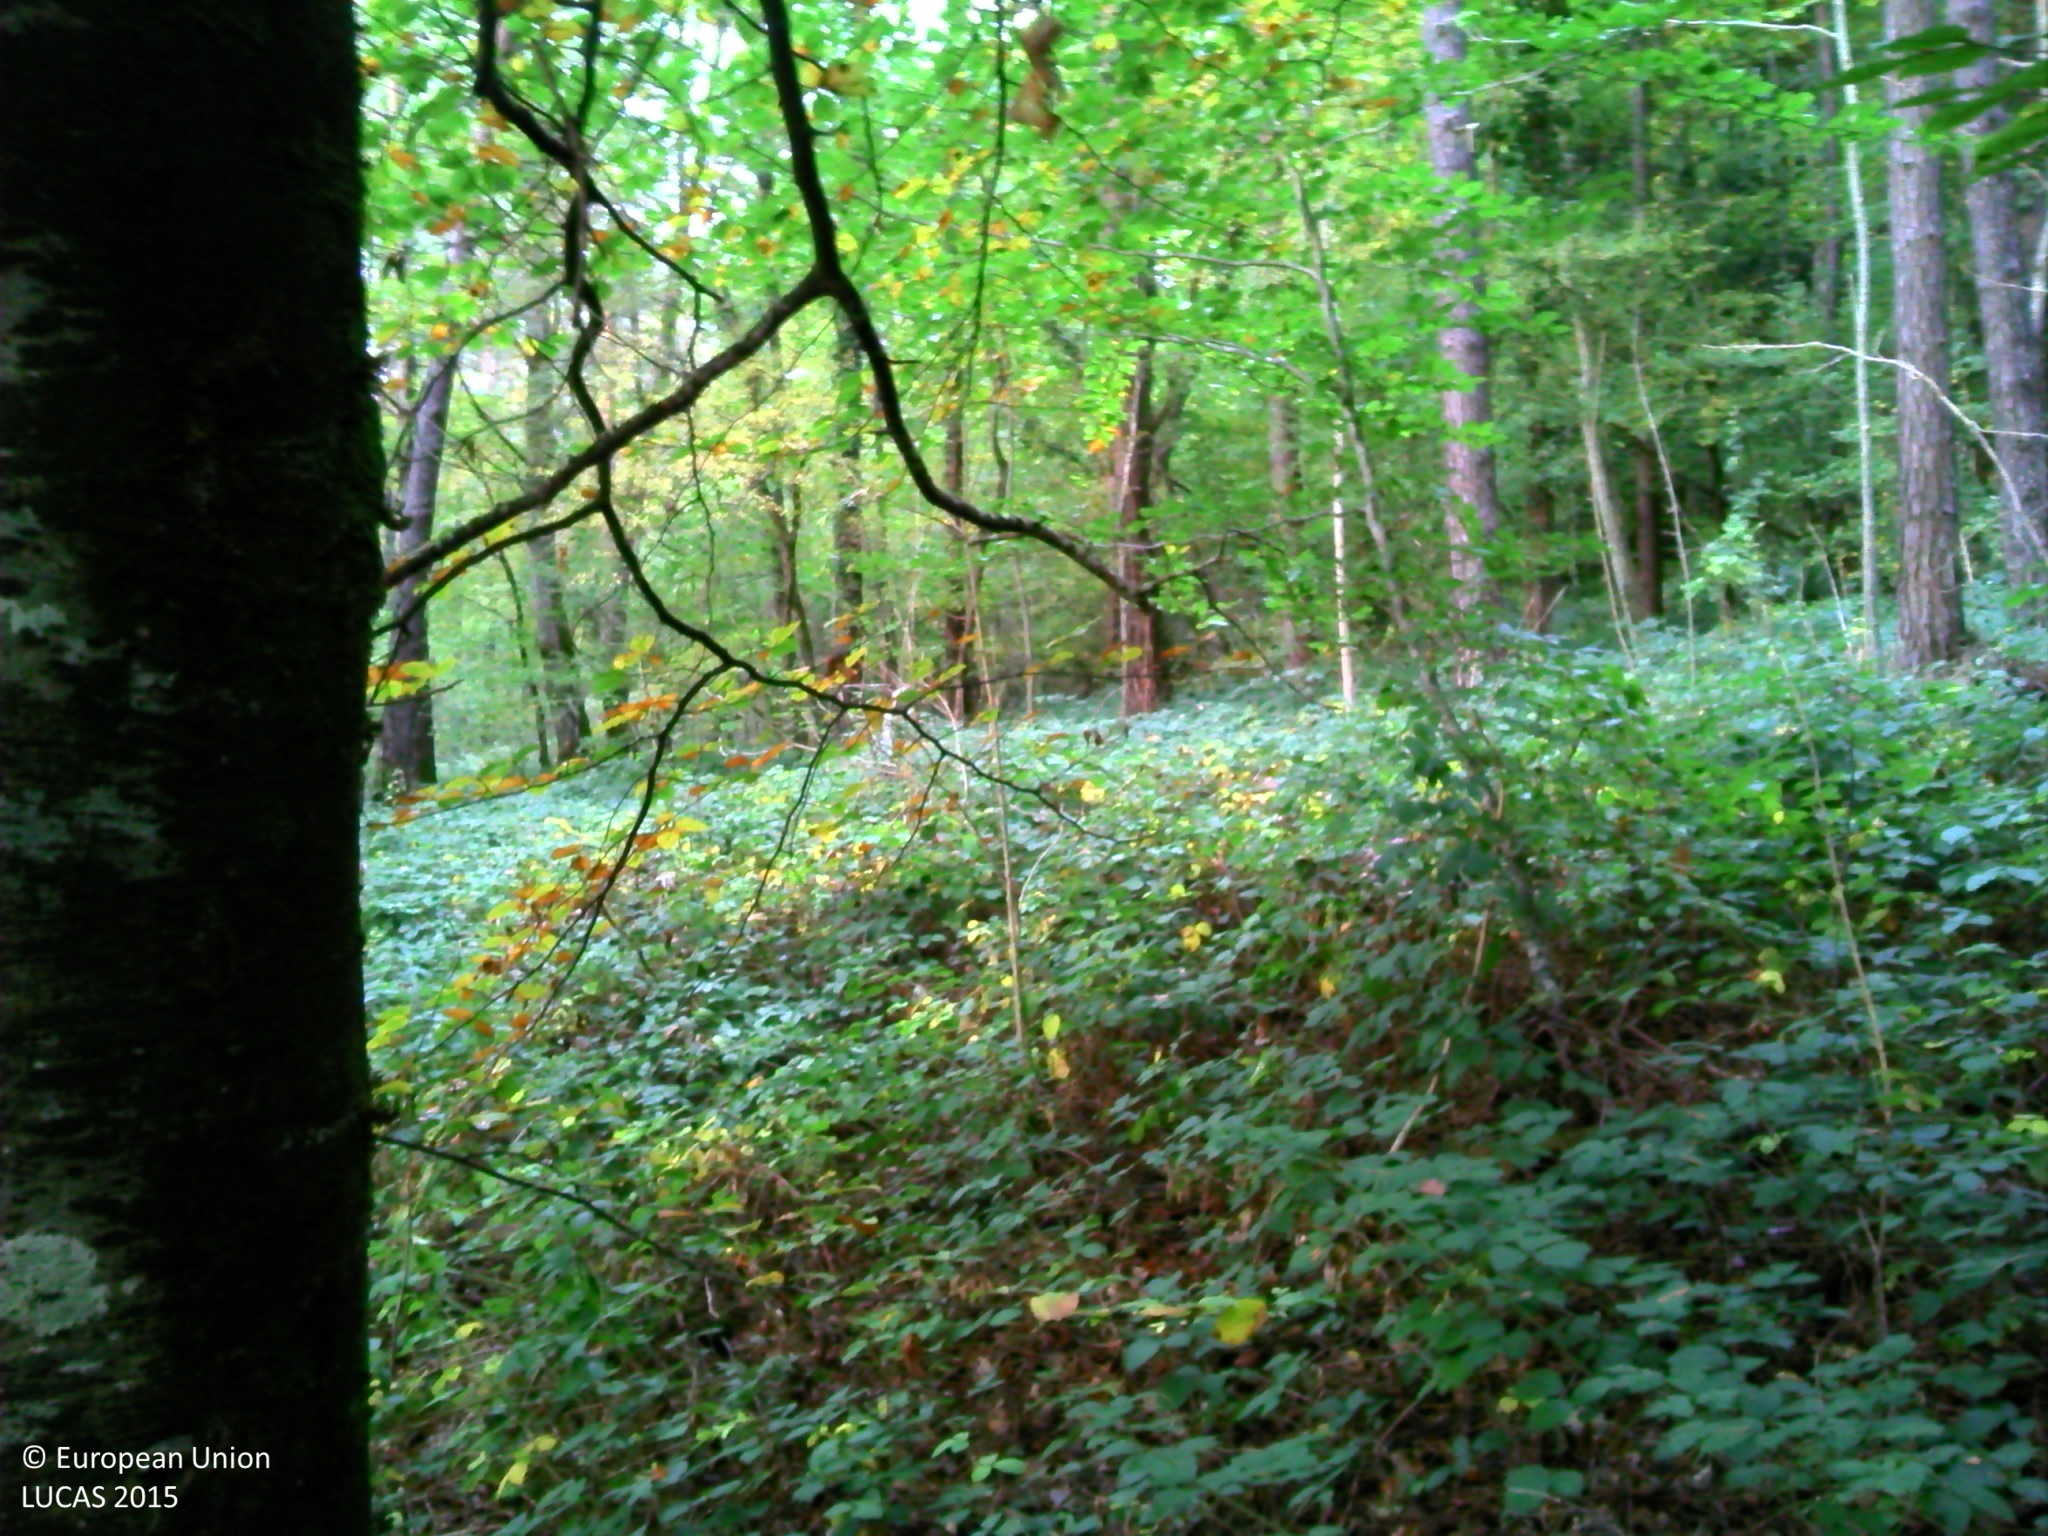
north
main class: Woodland
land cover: Broadleaved woodland
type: beech forest
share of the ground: > 75 %
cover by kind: broadleaved forest trees 90 %, shrubs 5 %, unconsolidated bare surface 5 %
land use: Forestry
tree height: > 5 m
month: October
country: FR
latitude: 47.1080
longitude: 6.0618
